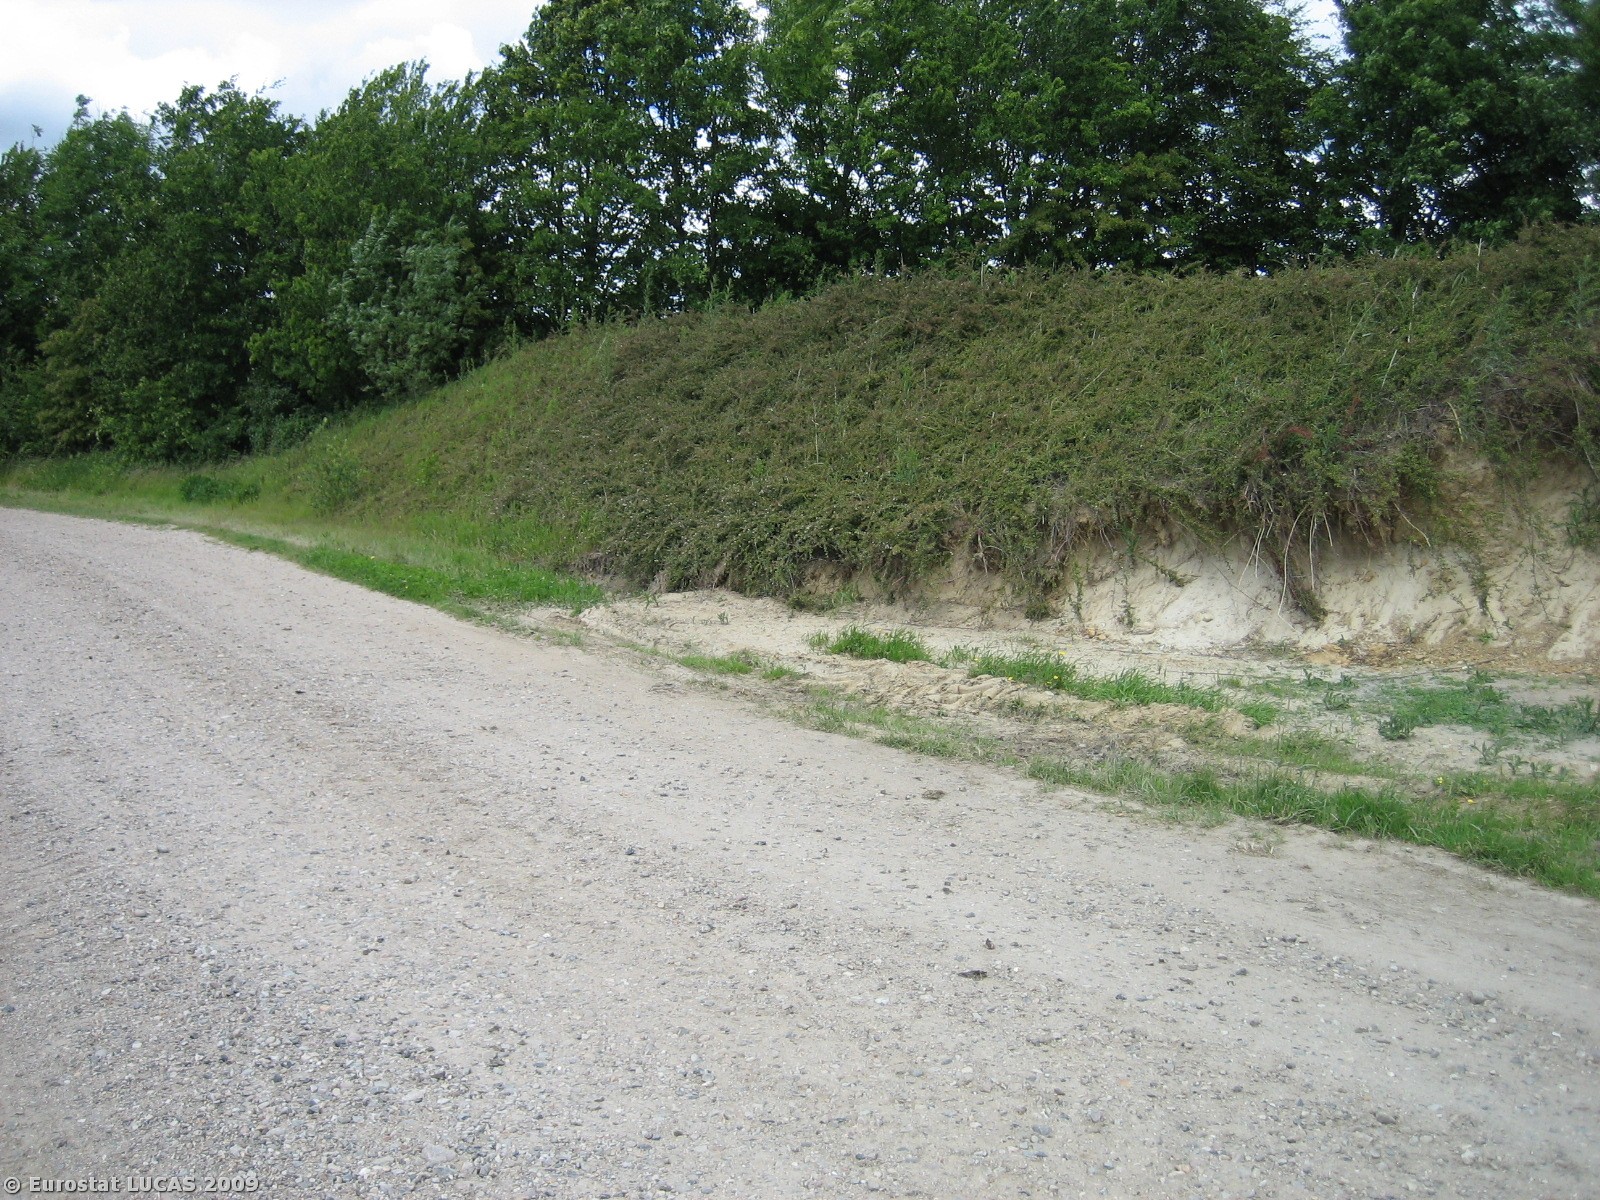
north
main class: Grassland
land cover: Grassland without tree/shrub cover
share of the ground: 10 - 25 %
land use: Agriculture (excluding fallow land and kitchen gardens)
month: June
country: DK
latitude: 55.7360
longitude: 9.2204
